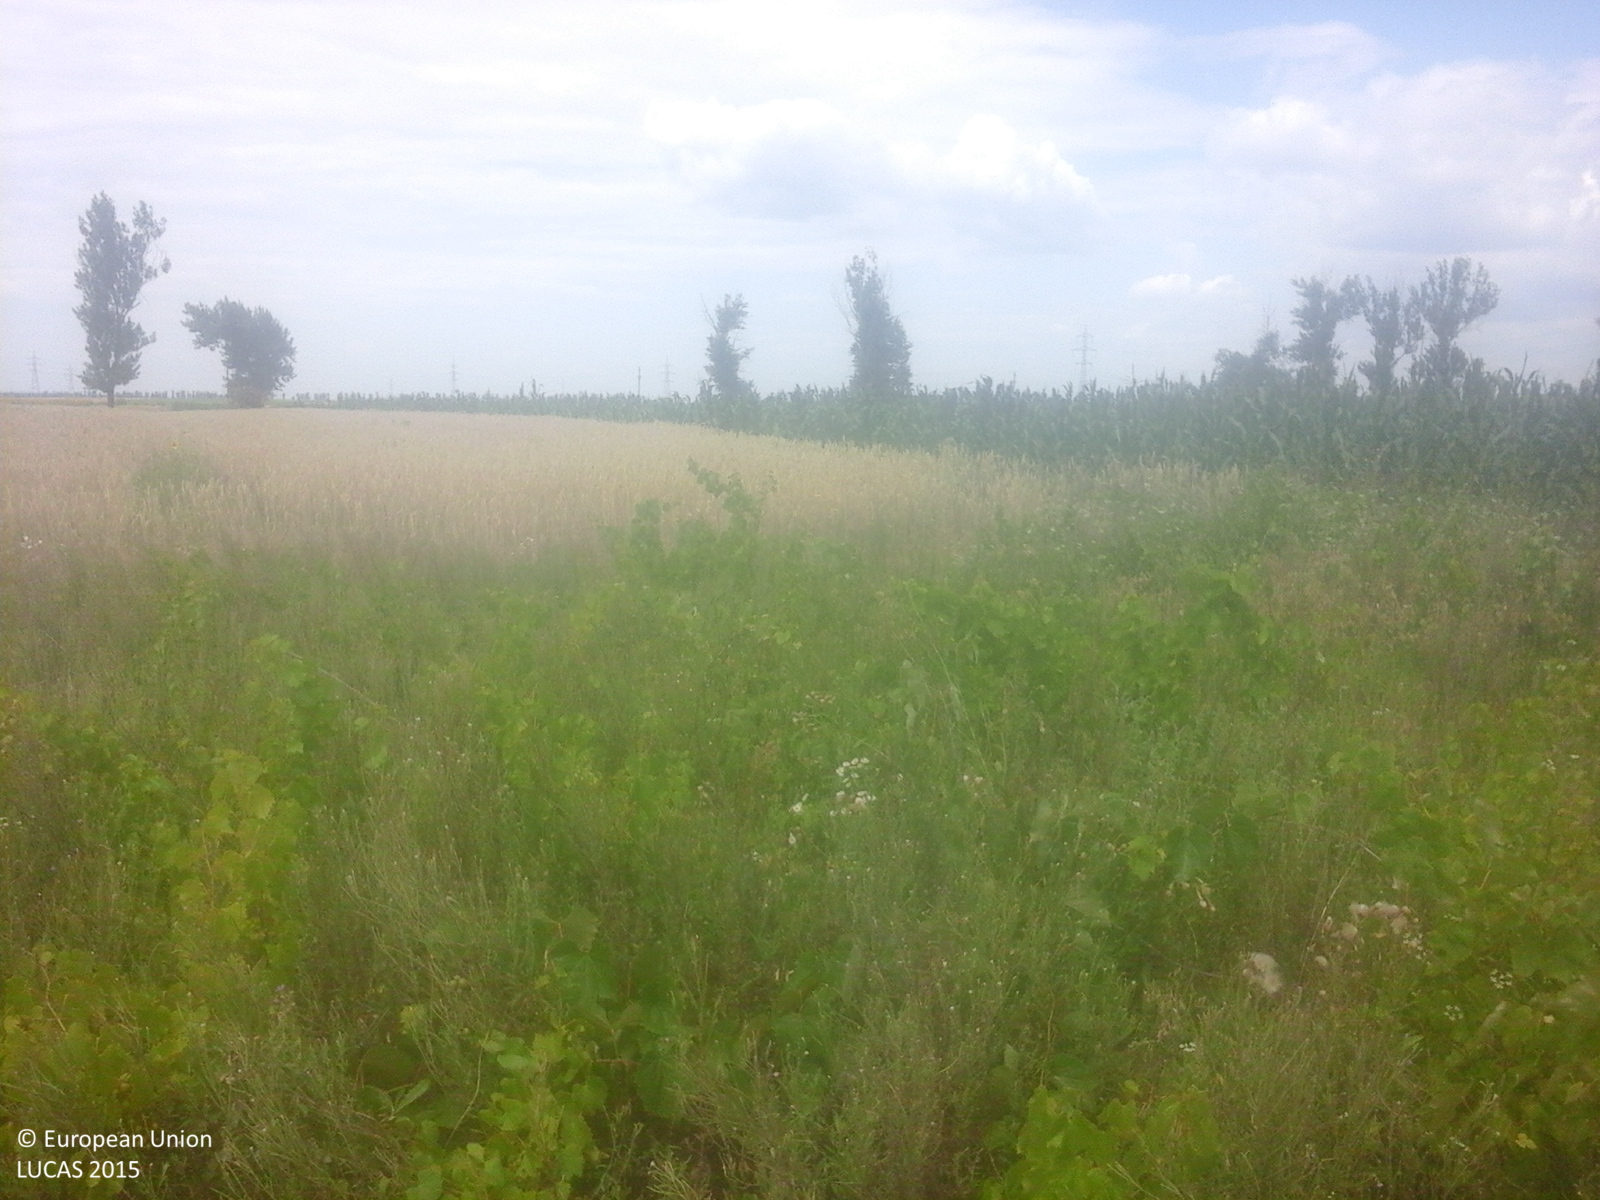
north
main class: Cropland
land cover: Vineyards
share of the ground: 50 - 75 %
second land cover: Spontaneously vegetated surfaces
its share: 50 - 75 %
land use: Abandoned areas
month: July
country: RO
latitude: 44.1451
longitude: 25.5281
